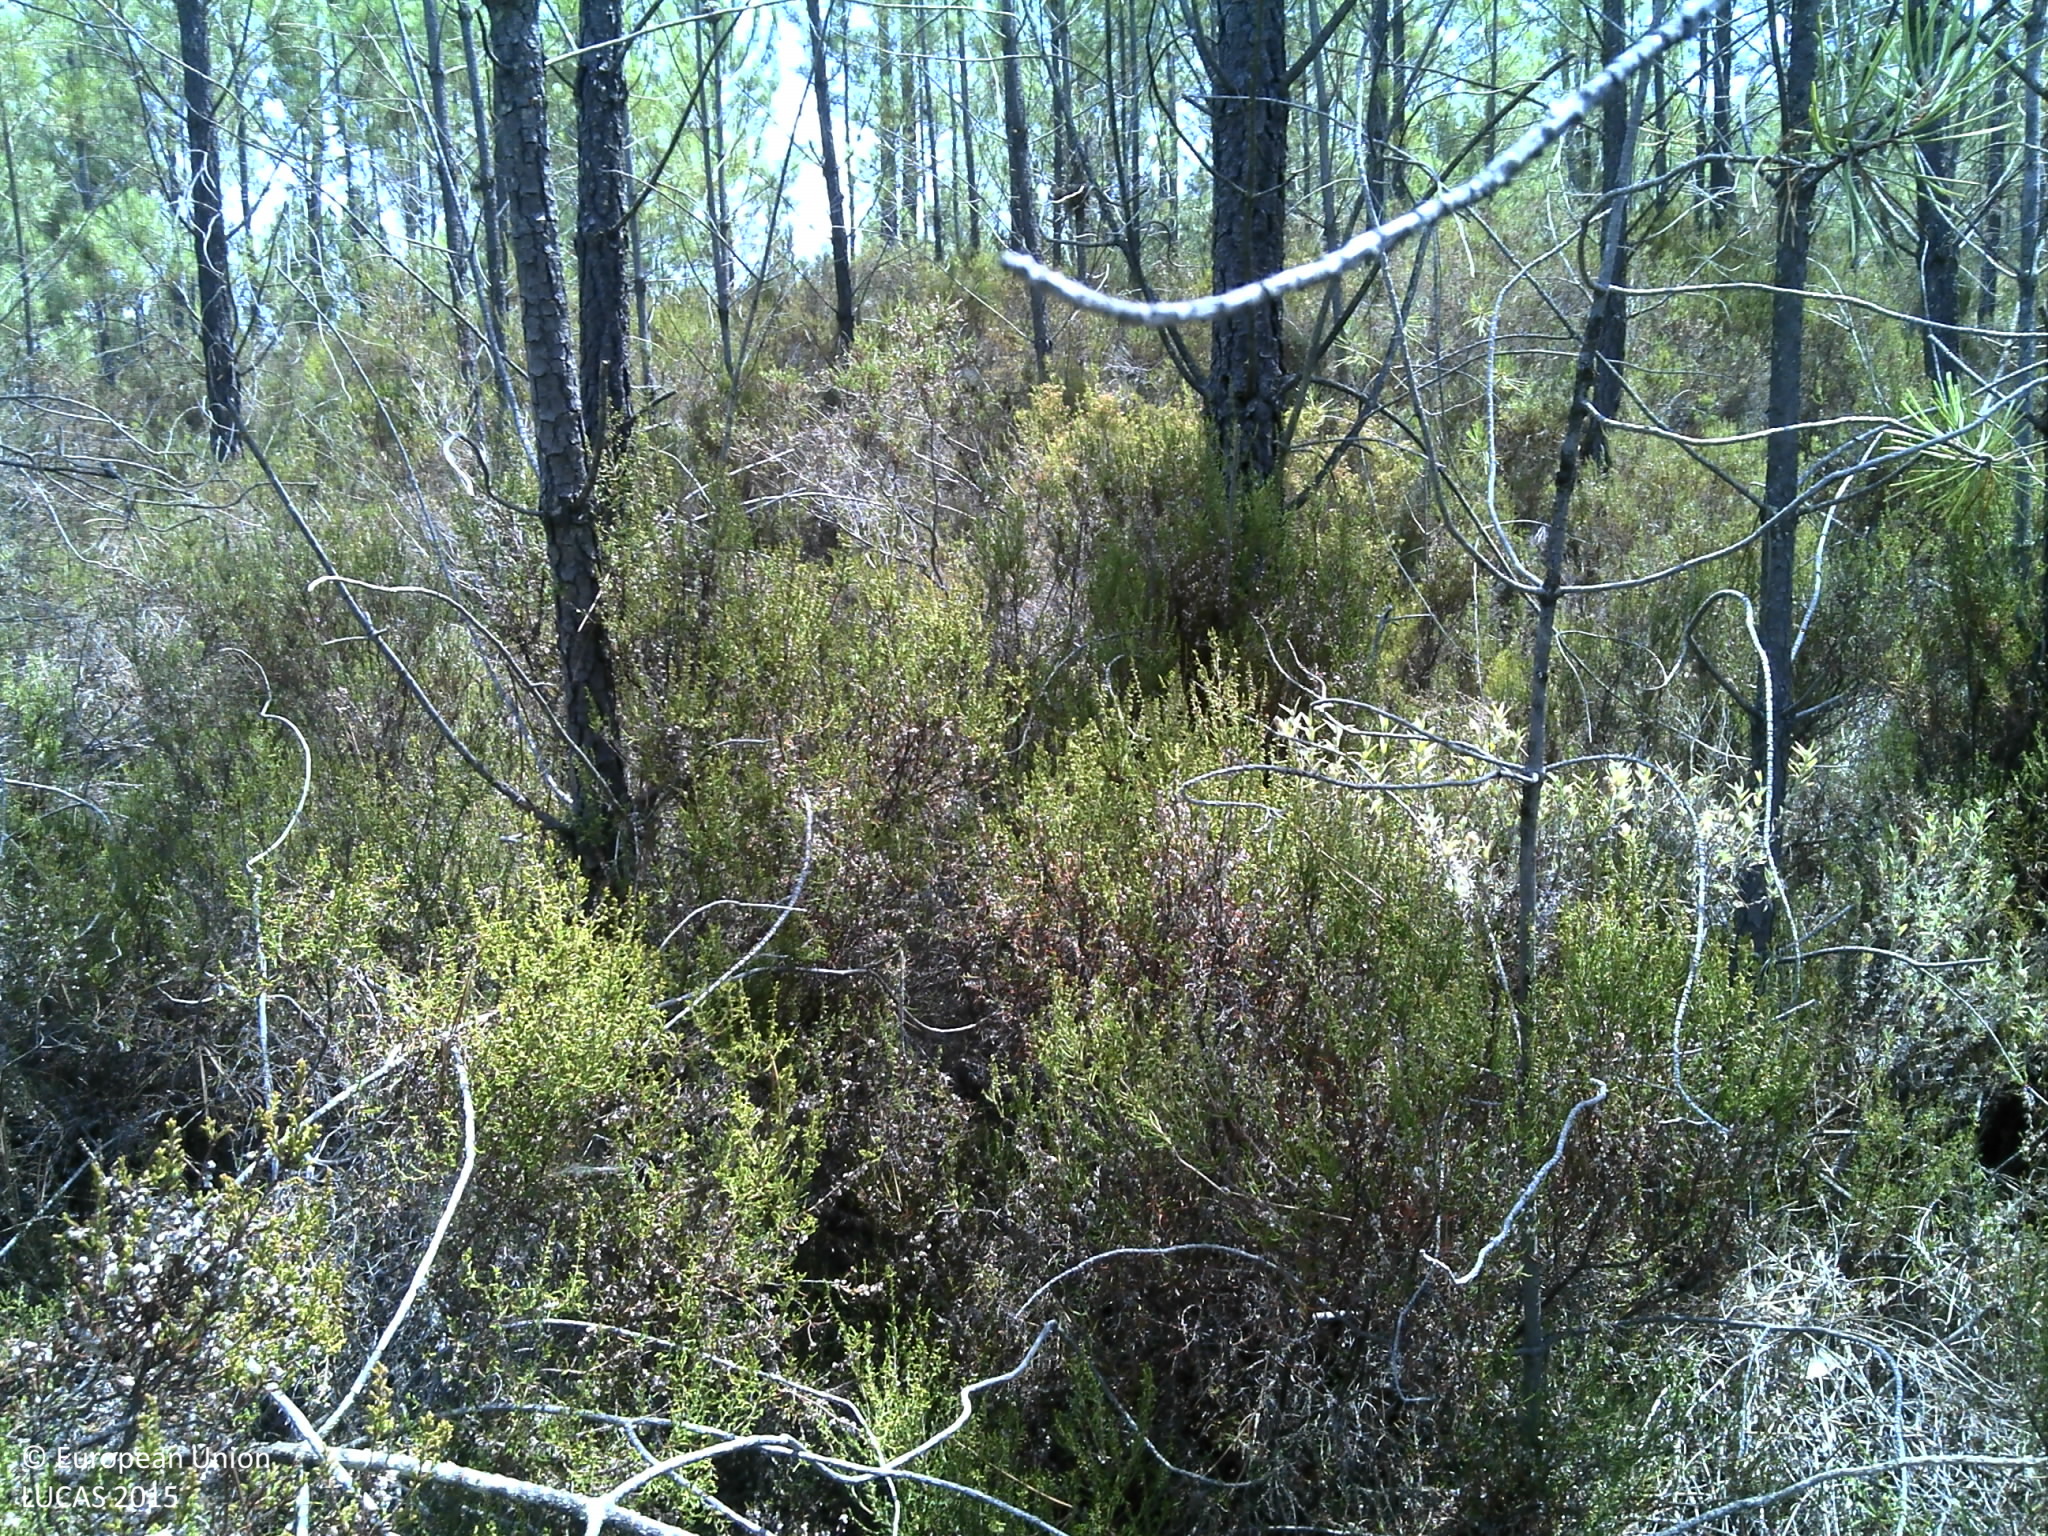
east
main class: Woodland
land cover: Pine dominated coniferous woodland
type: coniferous forest of the mediterranean region
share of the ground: 25 - 50 %
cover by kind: shrubs 55 %, coniferous forest trees 30 %, unconsolidated bare surface 10 %, consolidated bare surface 5 %
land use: Forestry
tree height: > 5 m
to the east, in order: Pine dominated coniferous woodland; Tracks; Shrubland with sparse tree cover; Pine dominated coniferous woodland
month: July
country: PT
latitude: 39.5802
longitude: -8.0255
